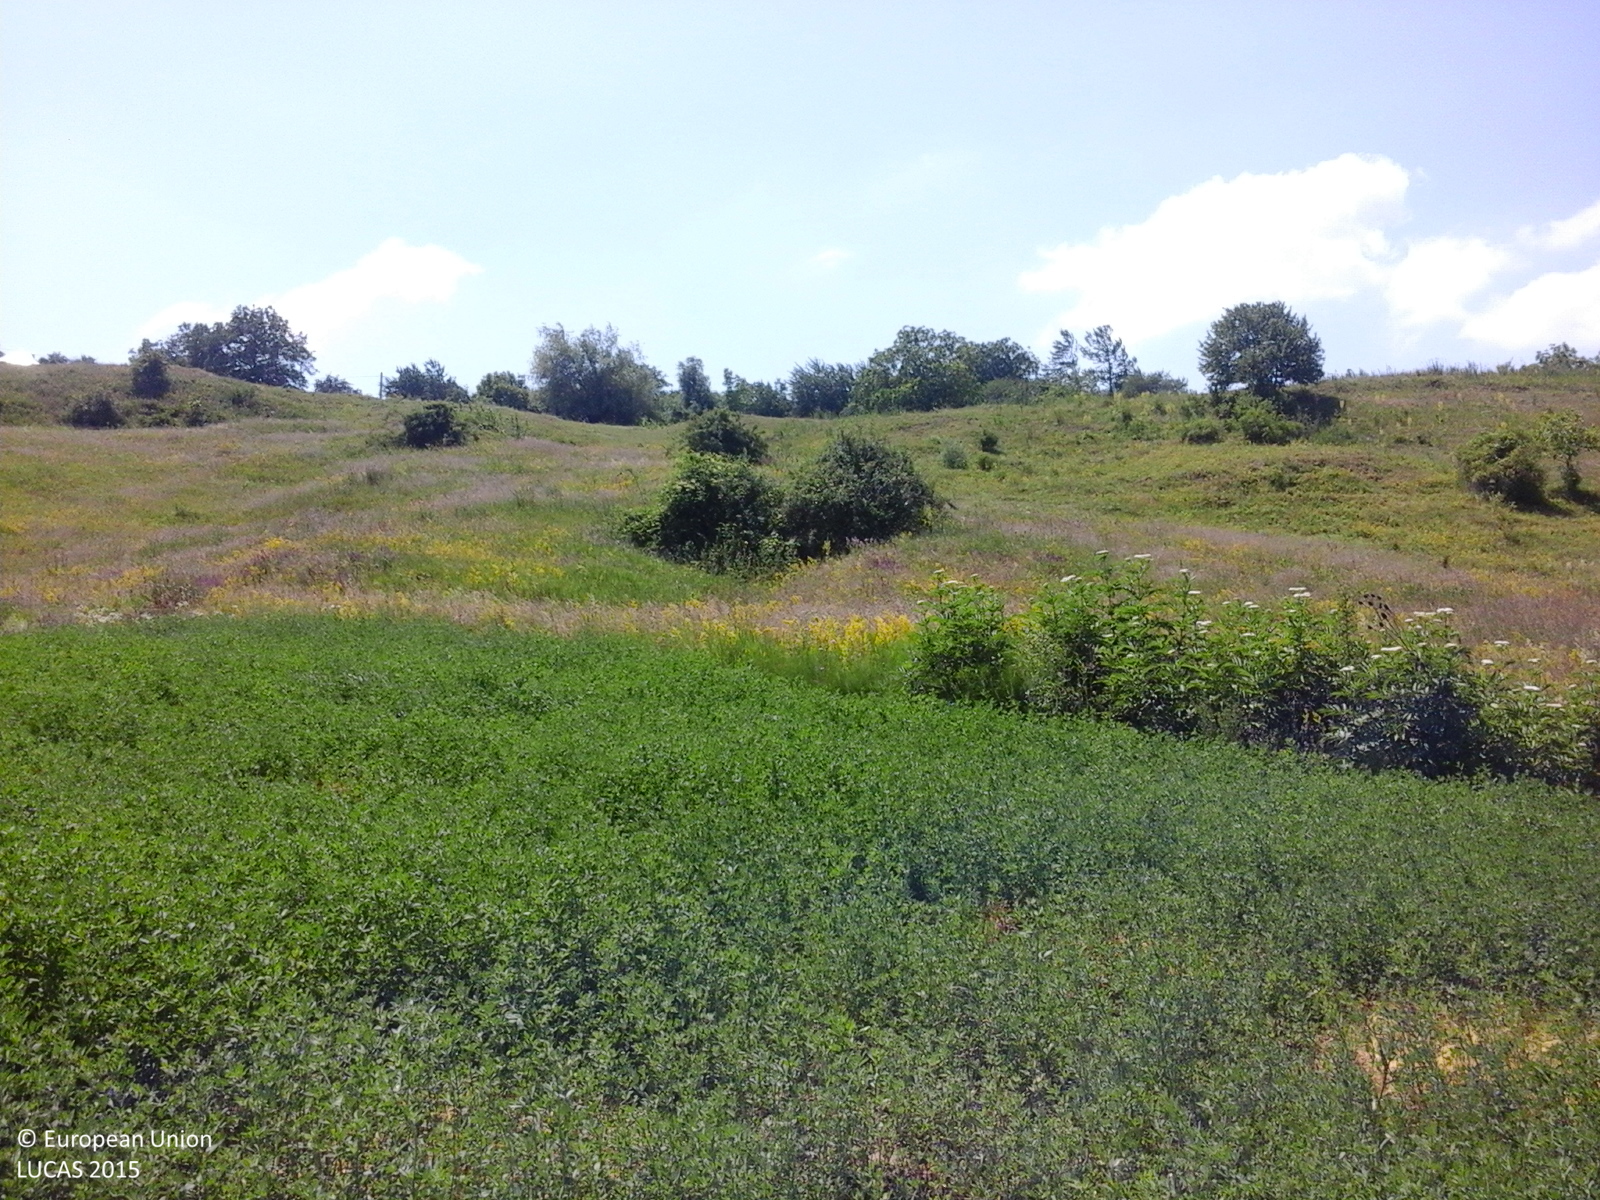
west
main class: Cropland
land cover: Lucerne
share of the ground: > 75 %
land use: Agriculture (excluding fallow land and kitchen gardens)
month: June
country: RO
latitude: 46.7946
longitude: 27.3630
